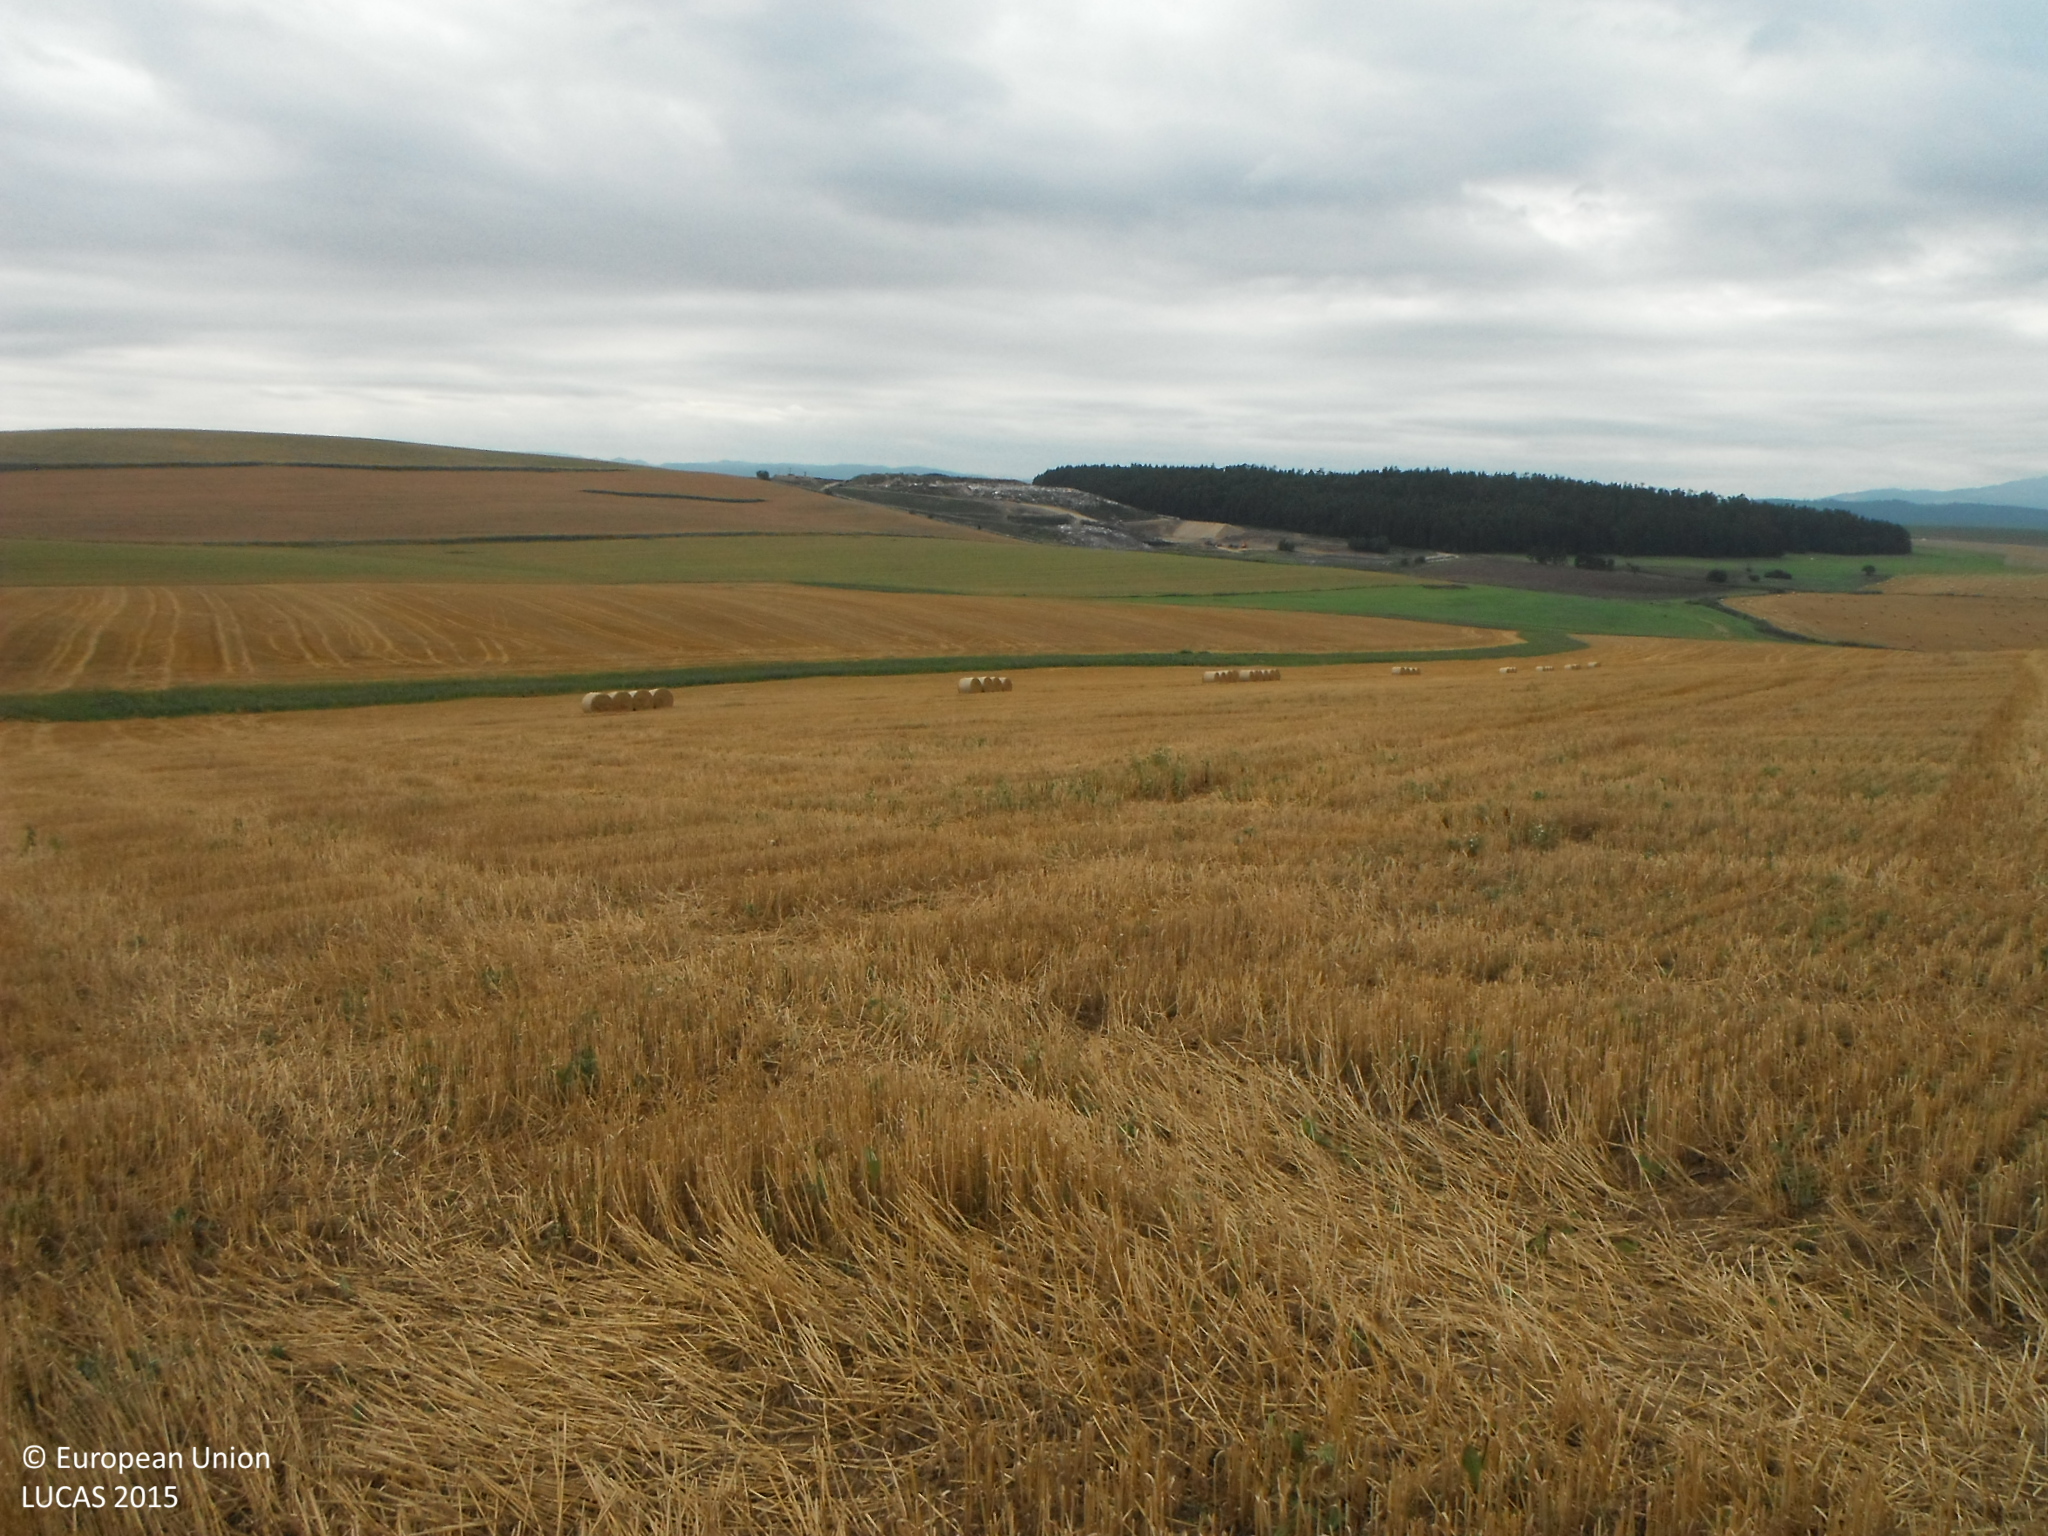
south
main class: Cropland
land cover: Barley
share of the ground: > 75 %
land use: Agriculture (excluding fallow land and kitchen gardens)
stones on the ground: 25 - 50 %
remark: Harvested field
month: August
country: SK
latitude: 49.0753
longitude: 20.3704
